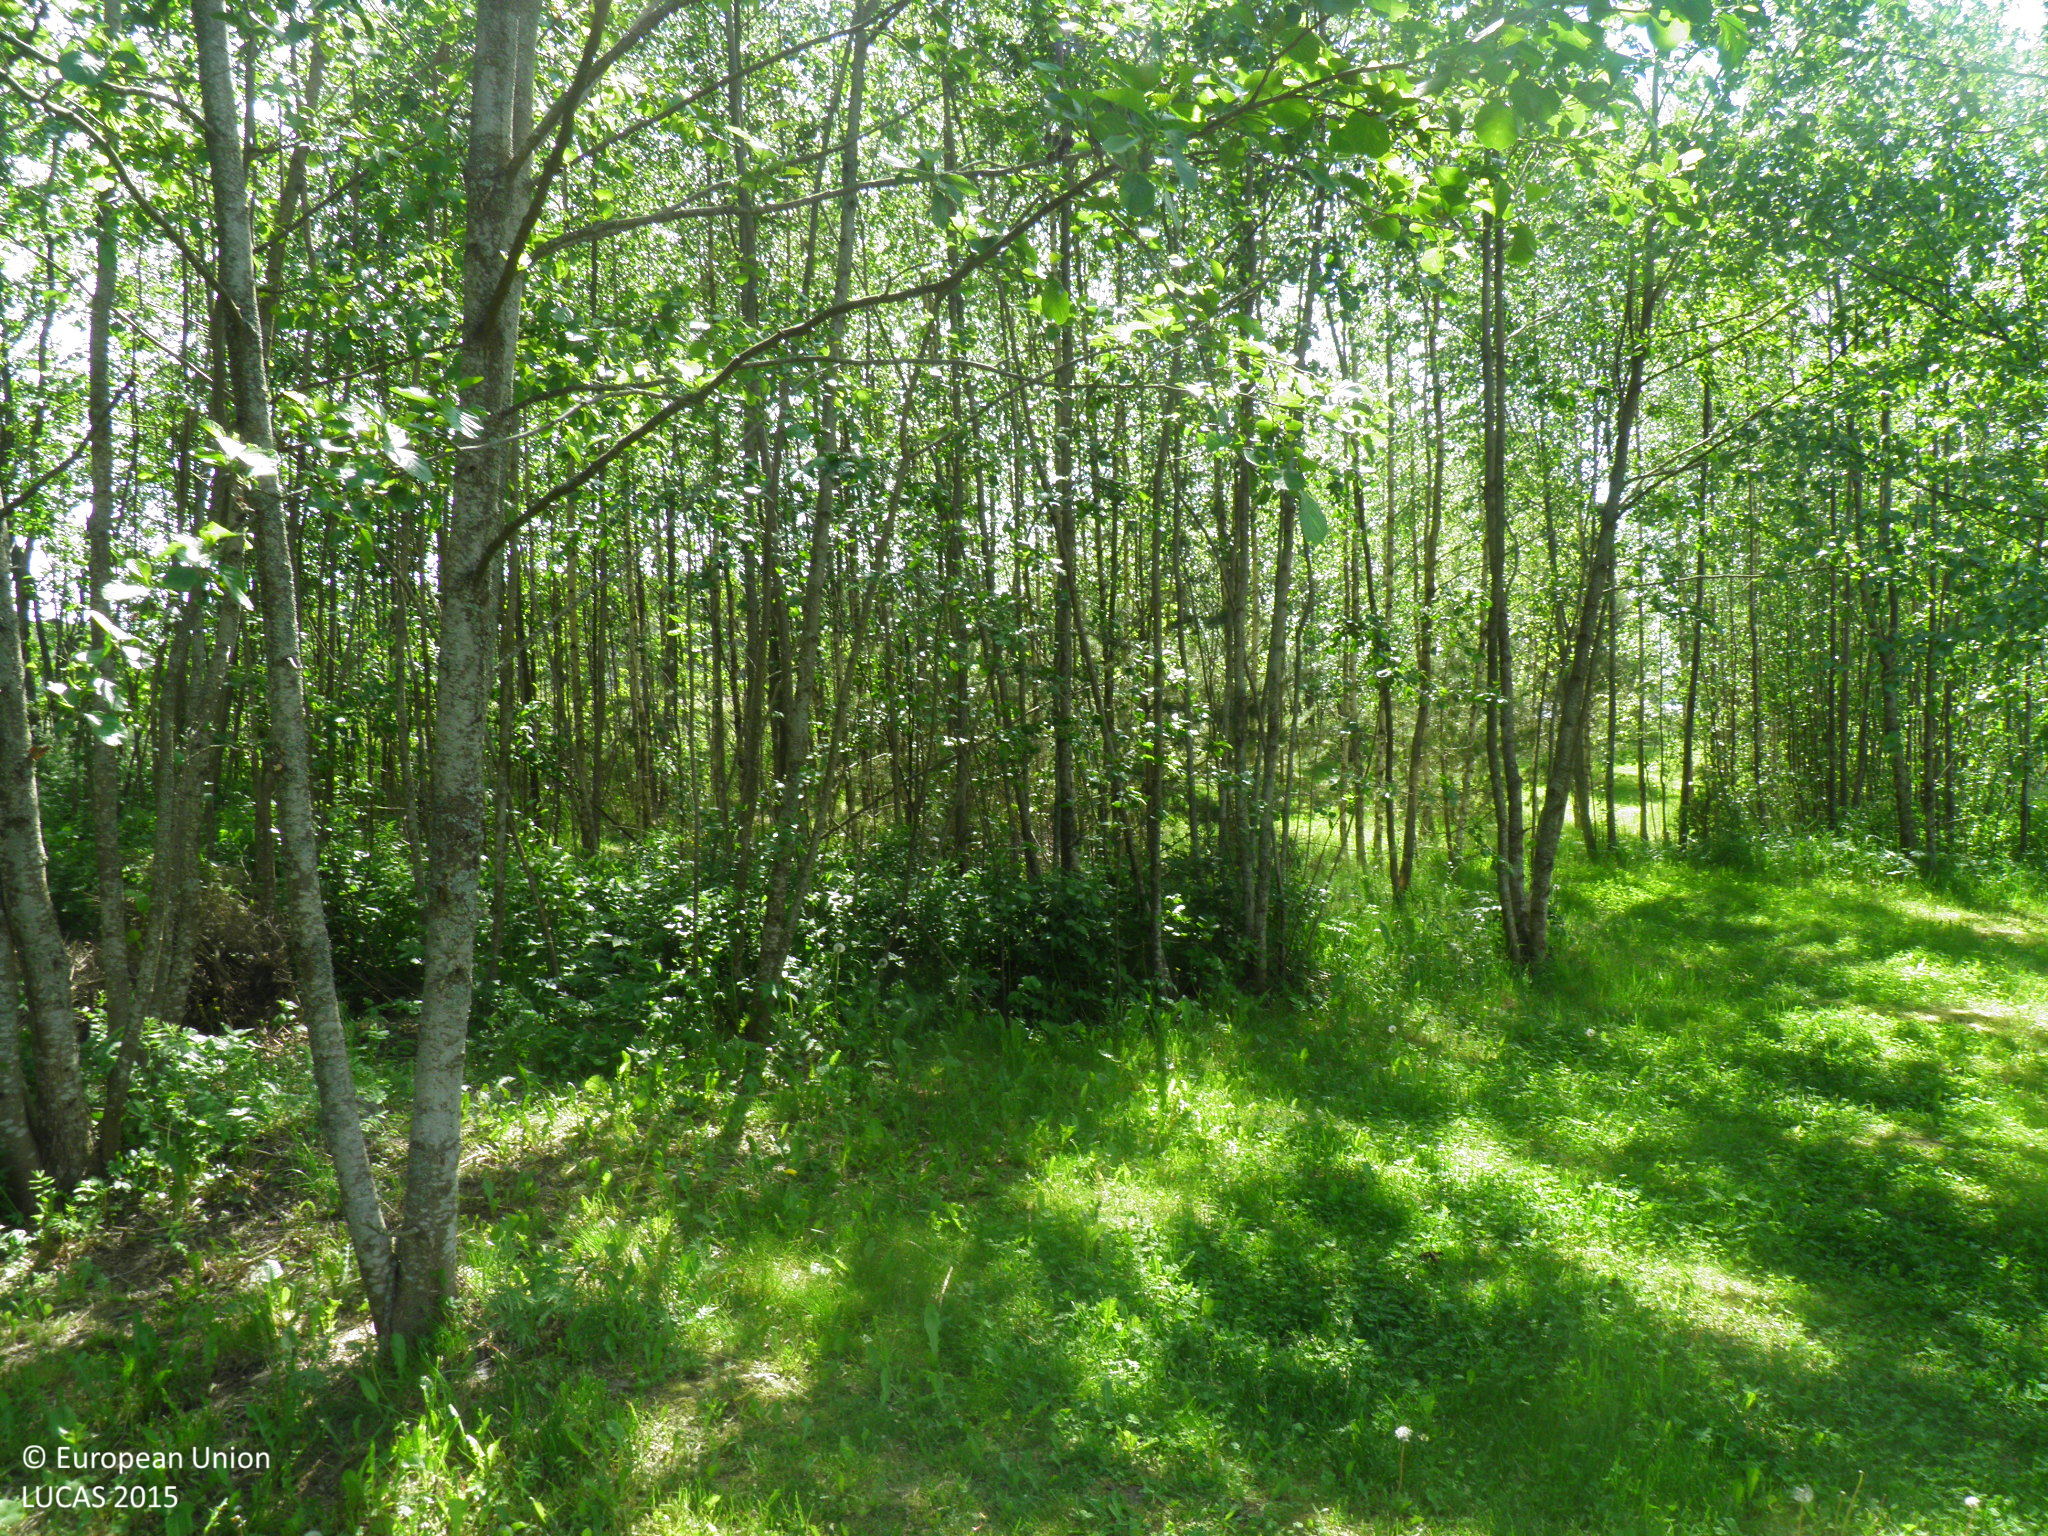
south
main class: Woodland
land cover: Broadleaved woodland
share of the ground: 50 - 75 %
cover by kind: broadleaved forest trees 55 %, herbaceous plants 45 %
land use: Amenities, museums, leisure
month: June
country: FI
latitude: 60.5567
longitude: 21.8235
